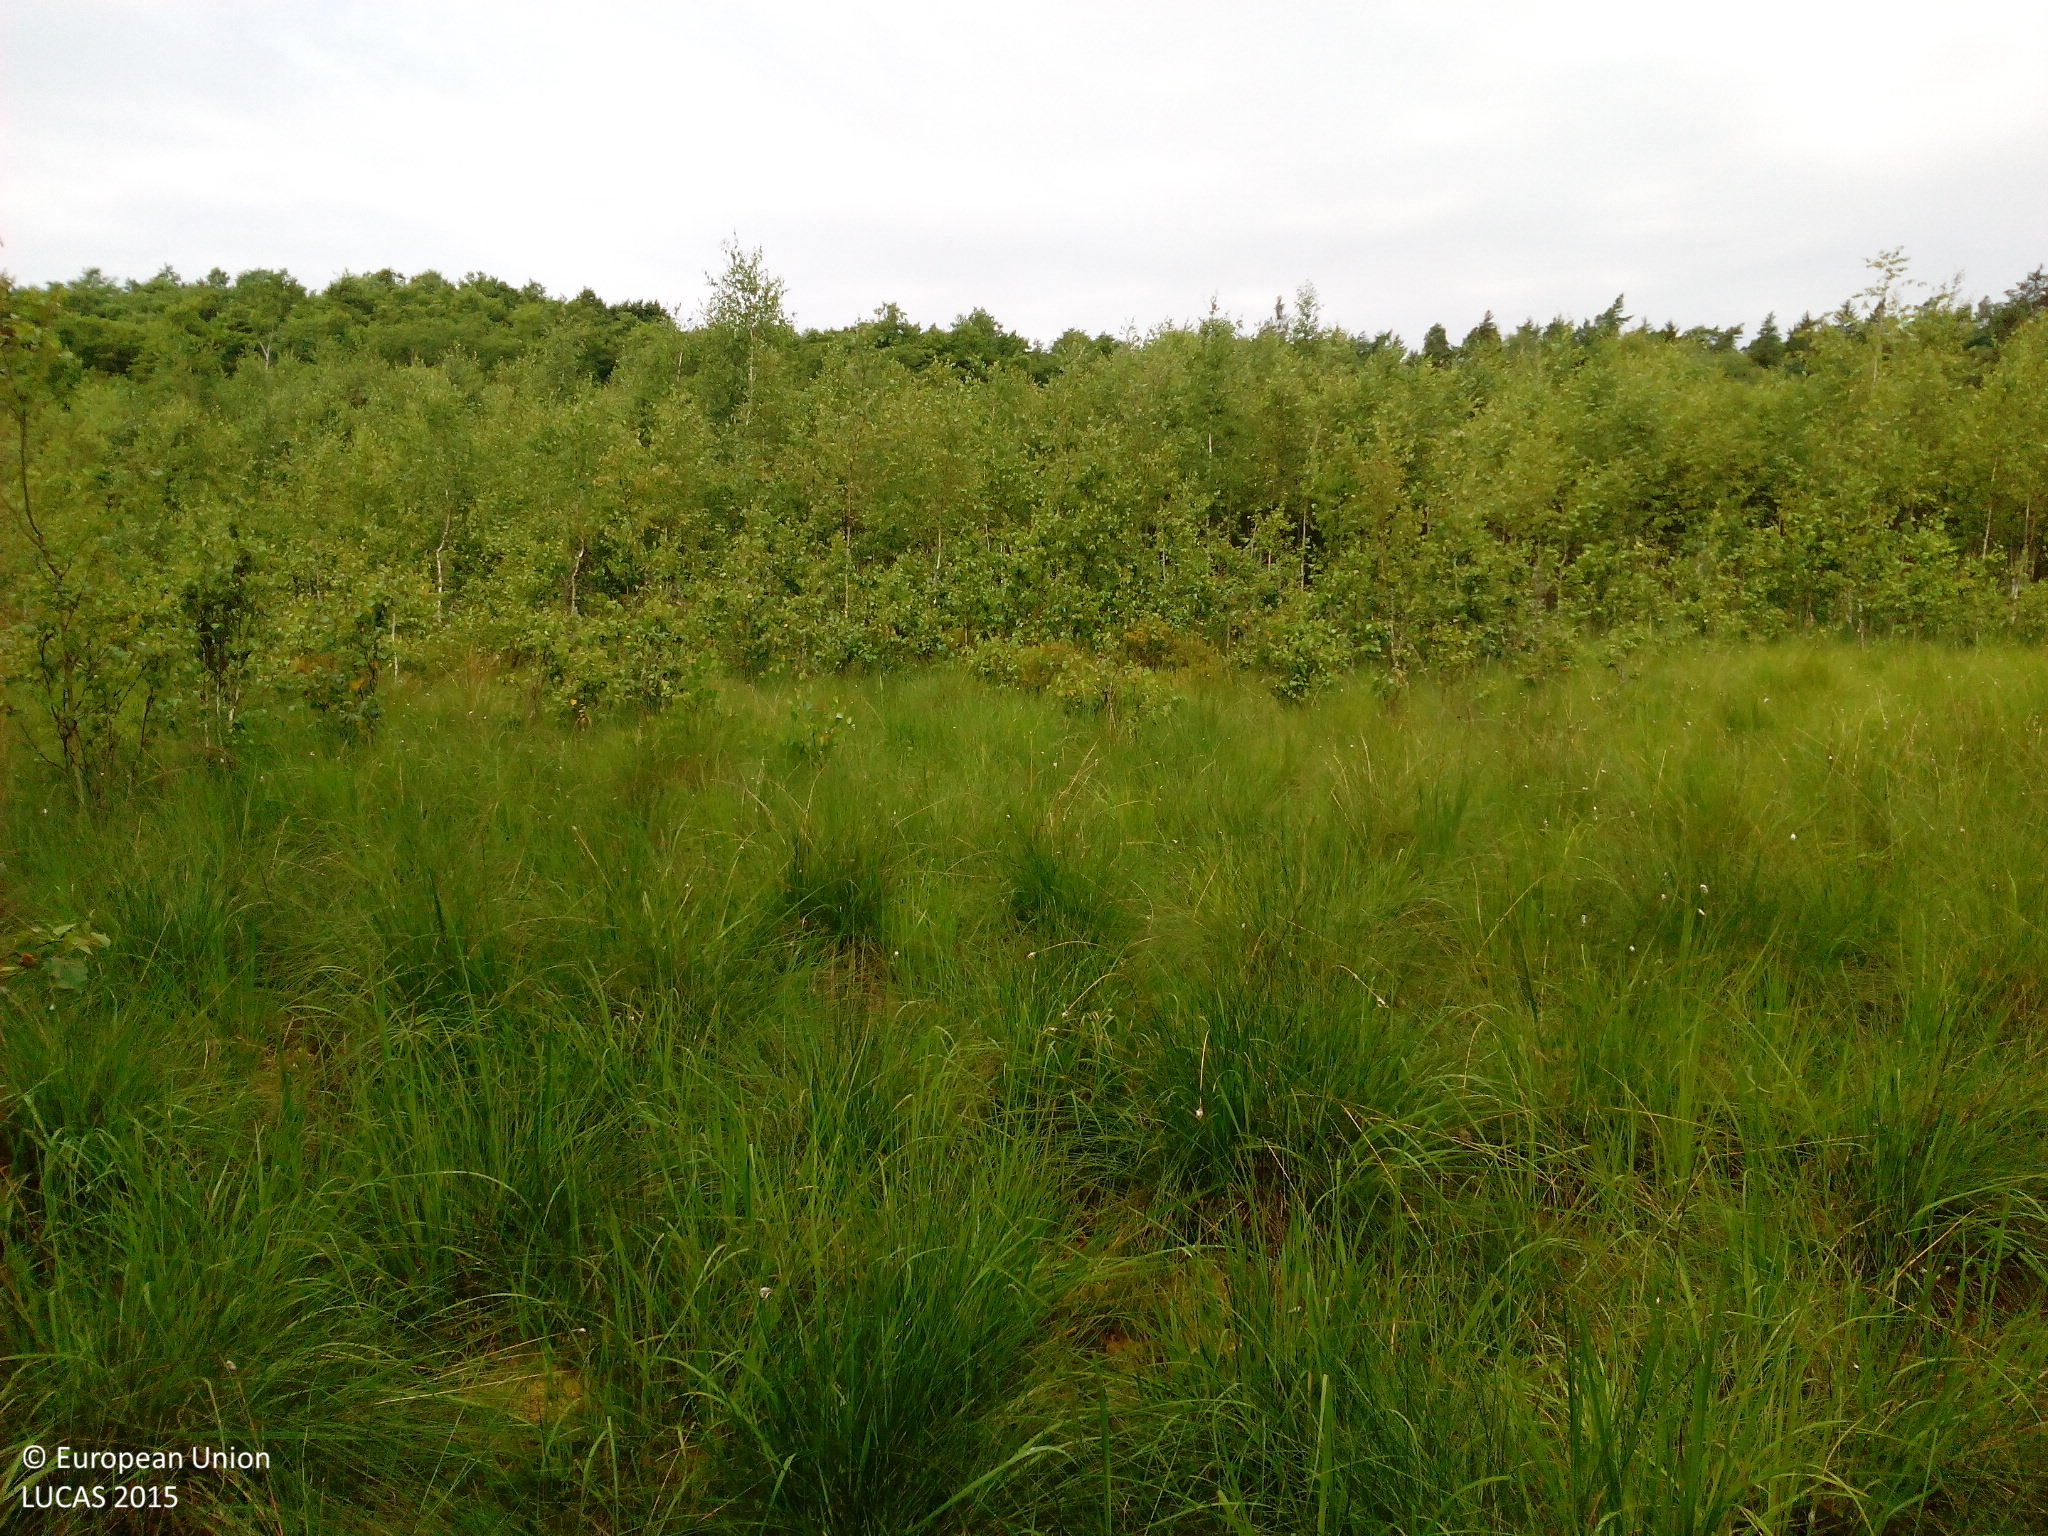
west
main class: Woodland
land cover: Broadleaved woodland
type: mesophytic deciduous forest
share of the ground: 25 - 50 %
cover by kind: broadleaved forest trees 30 %, herbaceous plants 30 %, shrubs 20 %, lichens and mosses 20 %
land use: Semi-natural and natural areas not in use
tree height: > 5 m
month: July
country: DE
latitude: 53.5595
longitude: 14.3033
